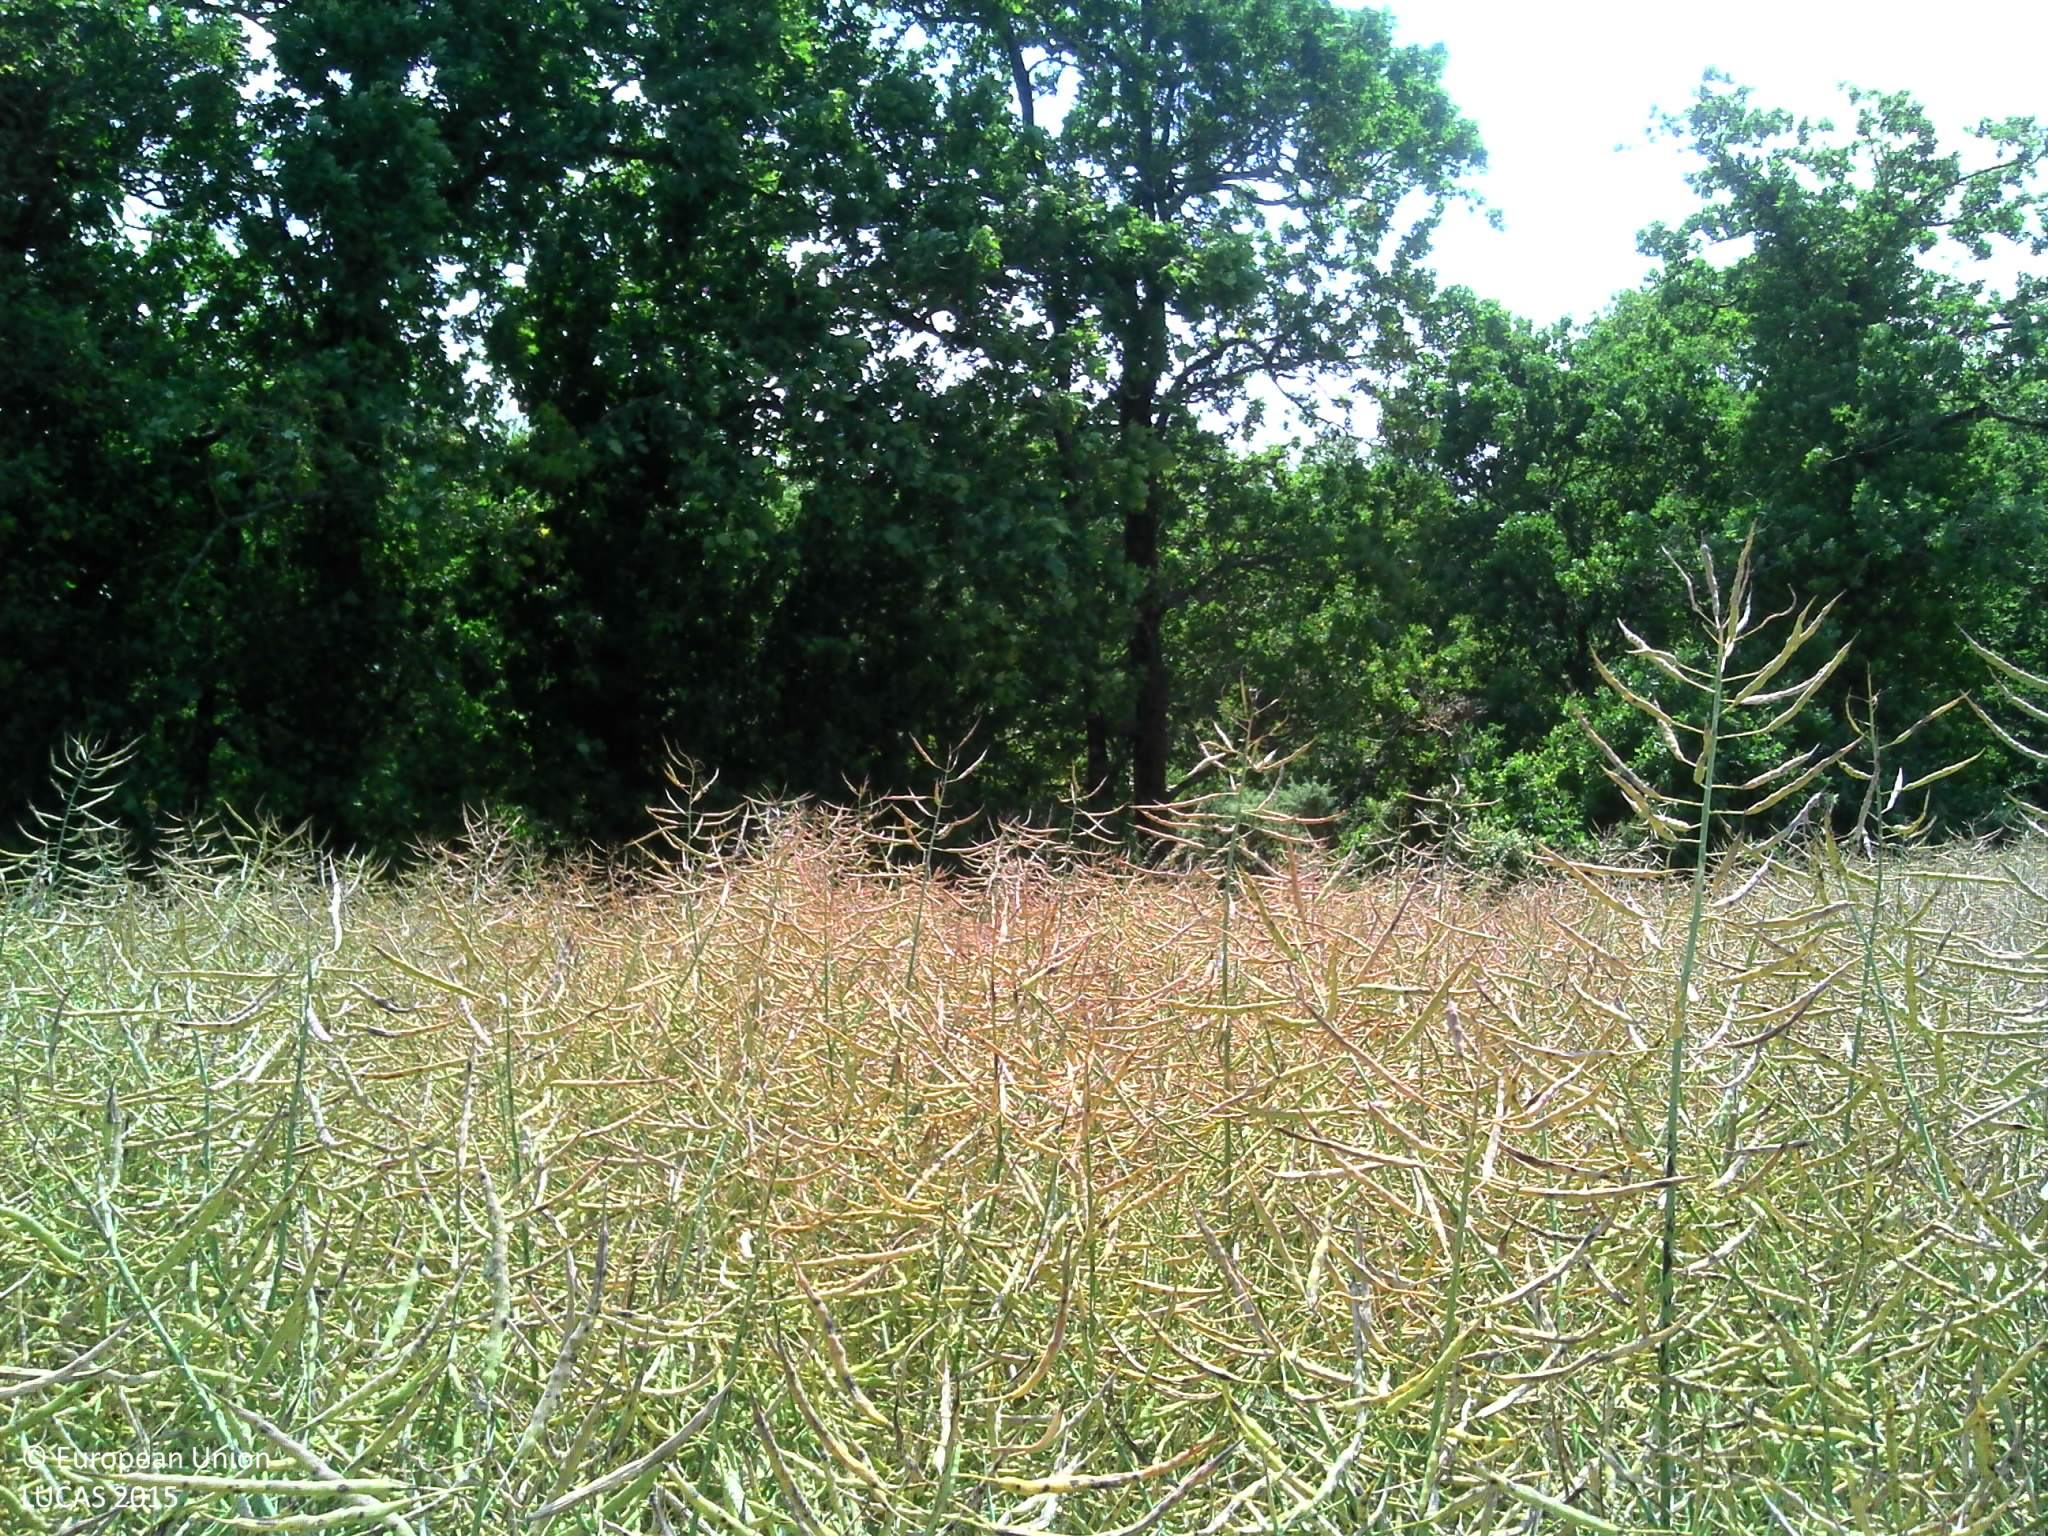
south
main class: Cropland
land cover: Rape and turnip rape
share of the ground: > 75 %
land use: Agriculture (excluding fallow land and kitchen gardens)
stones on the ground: 10 - 25 %
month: June
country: FR
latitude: 46.8020
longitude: -1.6637
